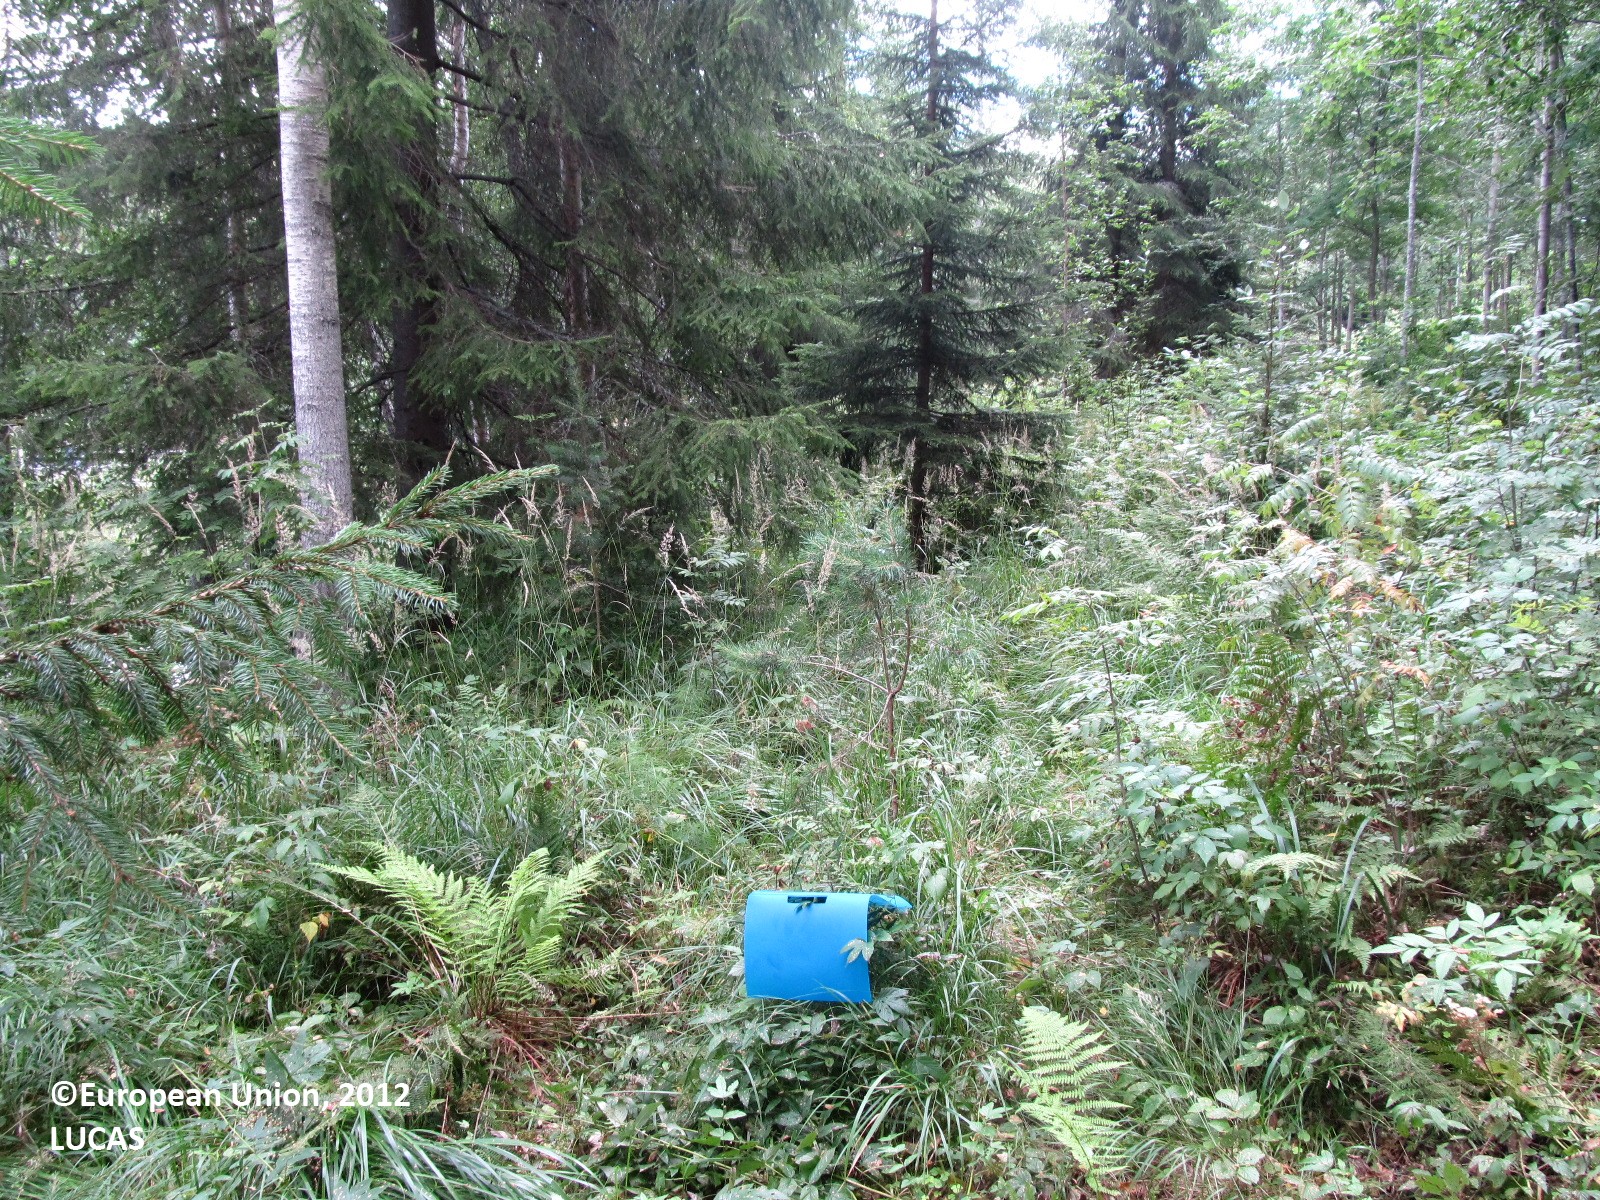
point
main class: Woodland
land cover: Spruce dominated mixed woodland
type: boreal forest
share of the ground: 50 - 75 %
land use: Forestry
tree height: > 5 m
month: August
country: FI
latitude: 61.7922
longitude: 27.8422
